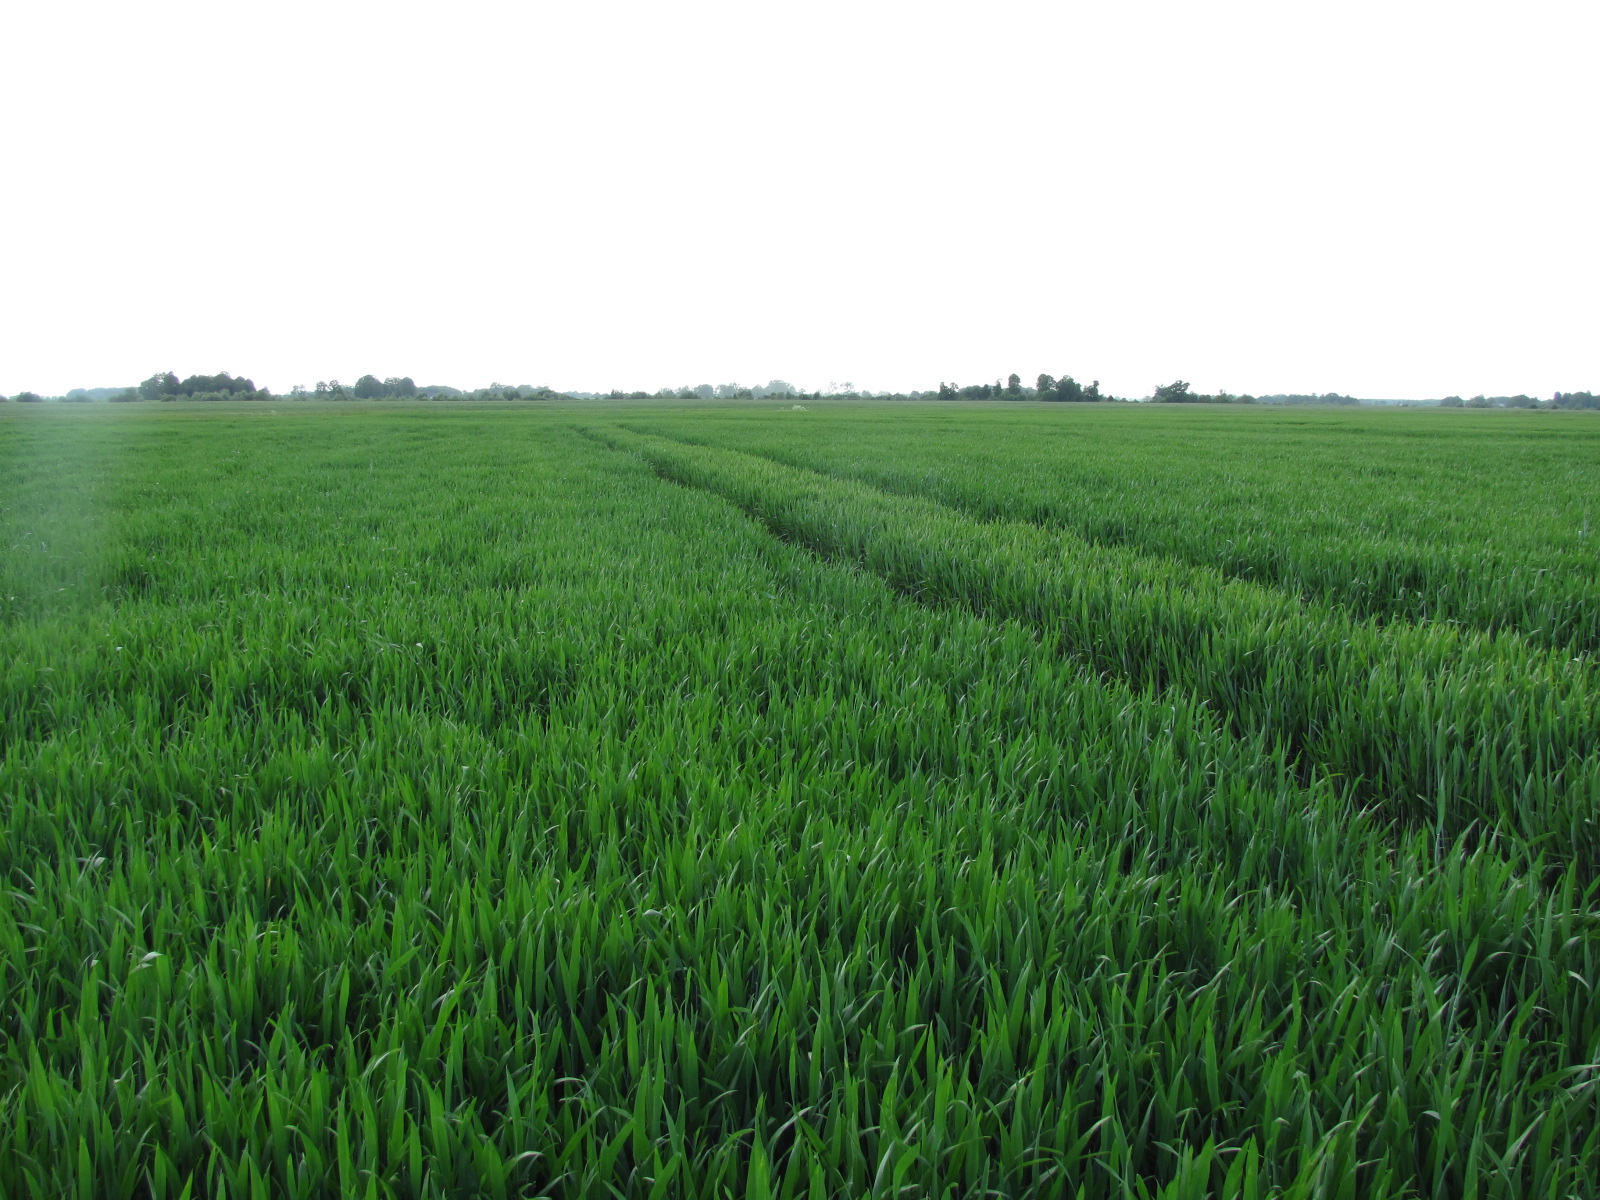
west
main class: Cropland
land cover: Common wheat
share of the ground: > 75 %
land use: Agriculture (excluding fallow land and kitchen gardens)
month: June
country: LV
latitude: 56.3280
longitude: 24.1756
